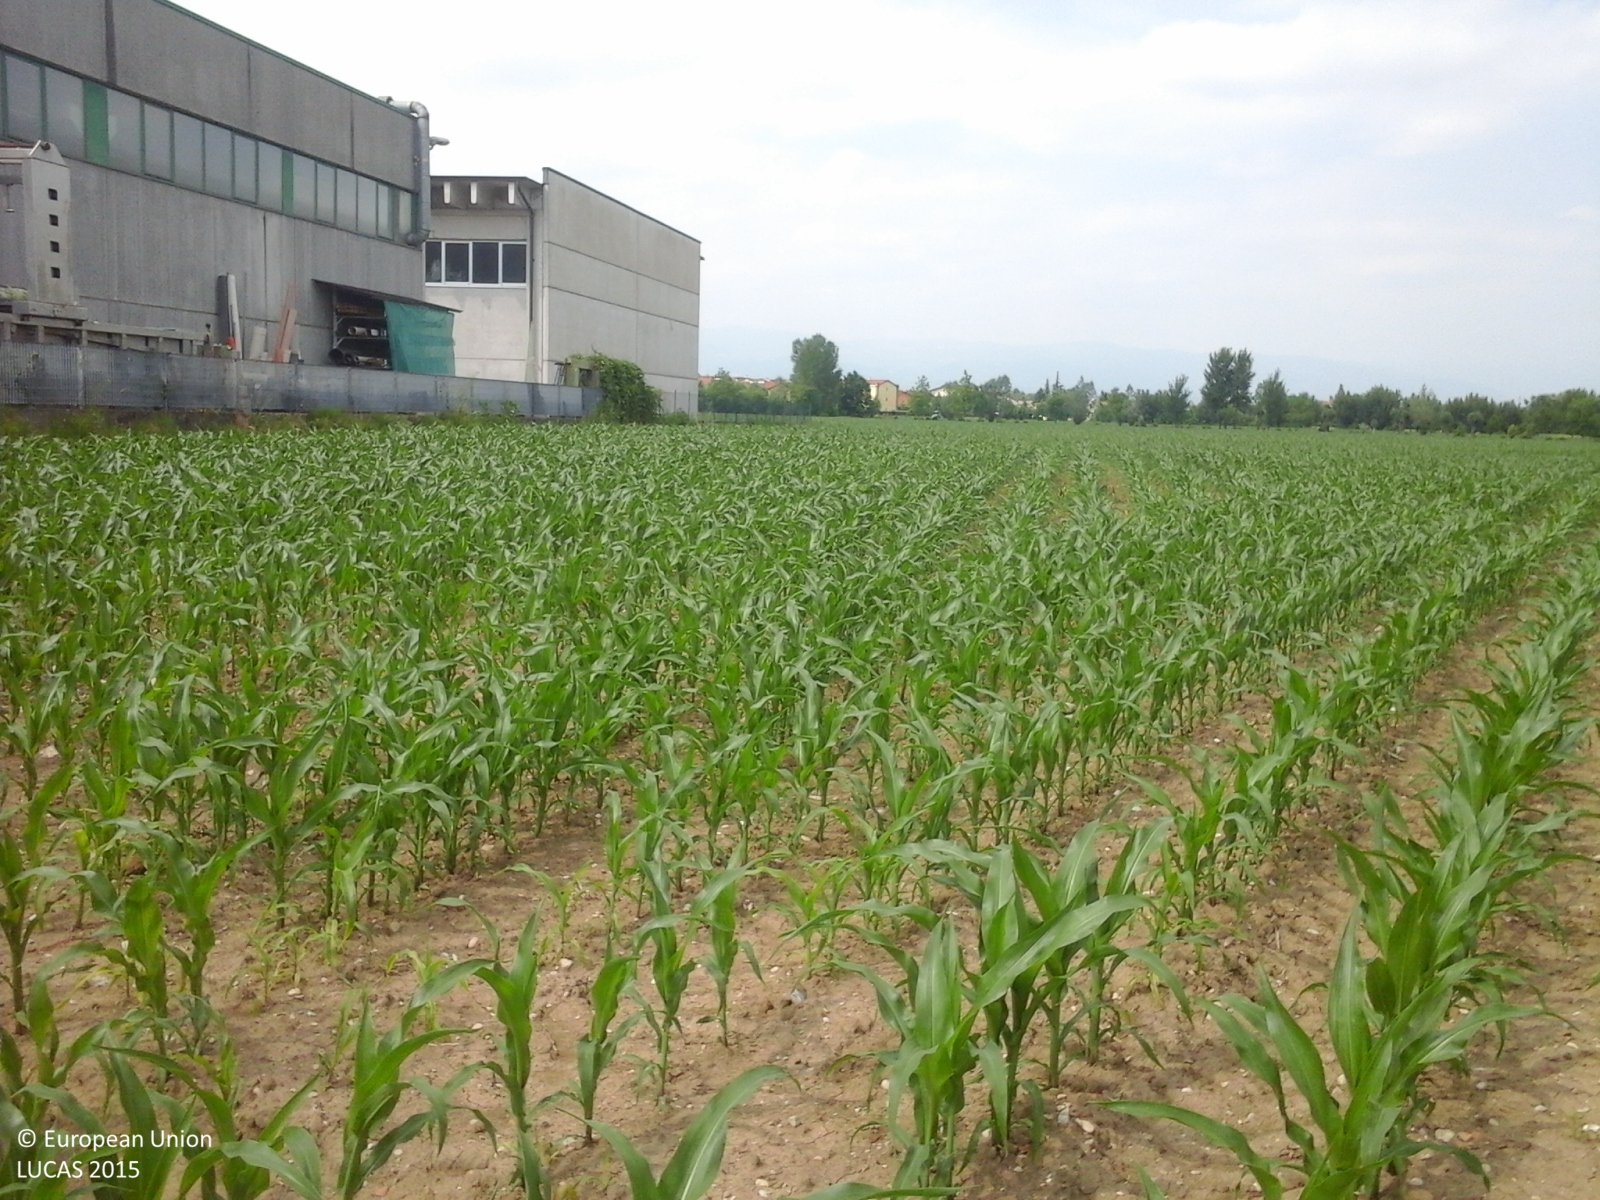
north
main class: Cropland
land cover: Maize
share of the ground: 25 - 50 %
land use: Agriculture (excluding fallow land and kitchen gardens)
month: May
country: IT
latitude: 45.6188
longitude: 11.5749
